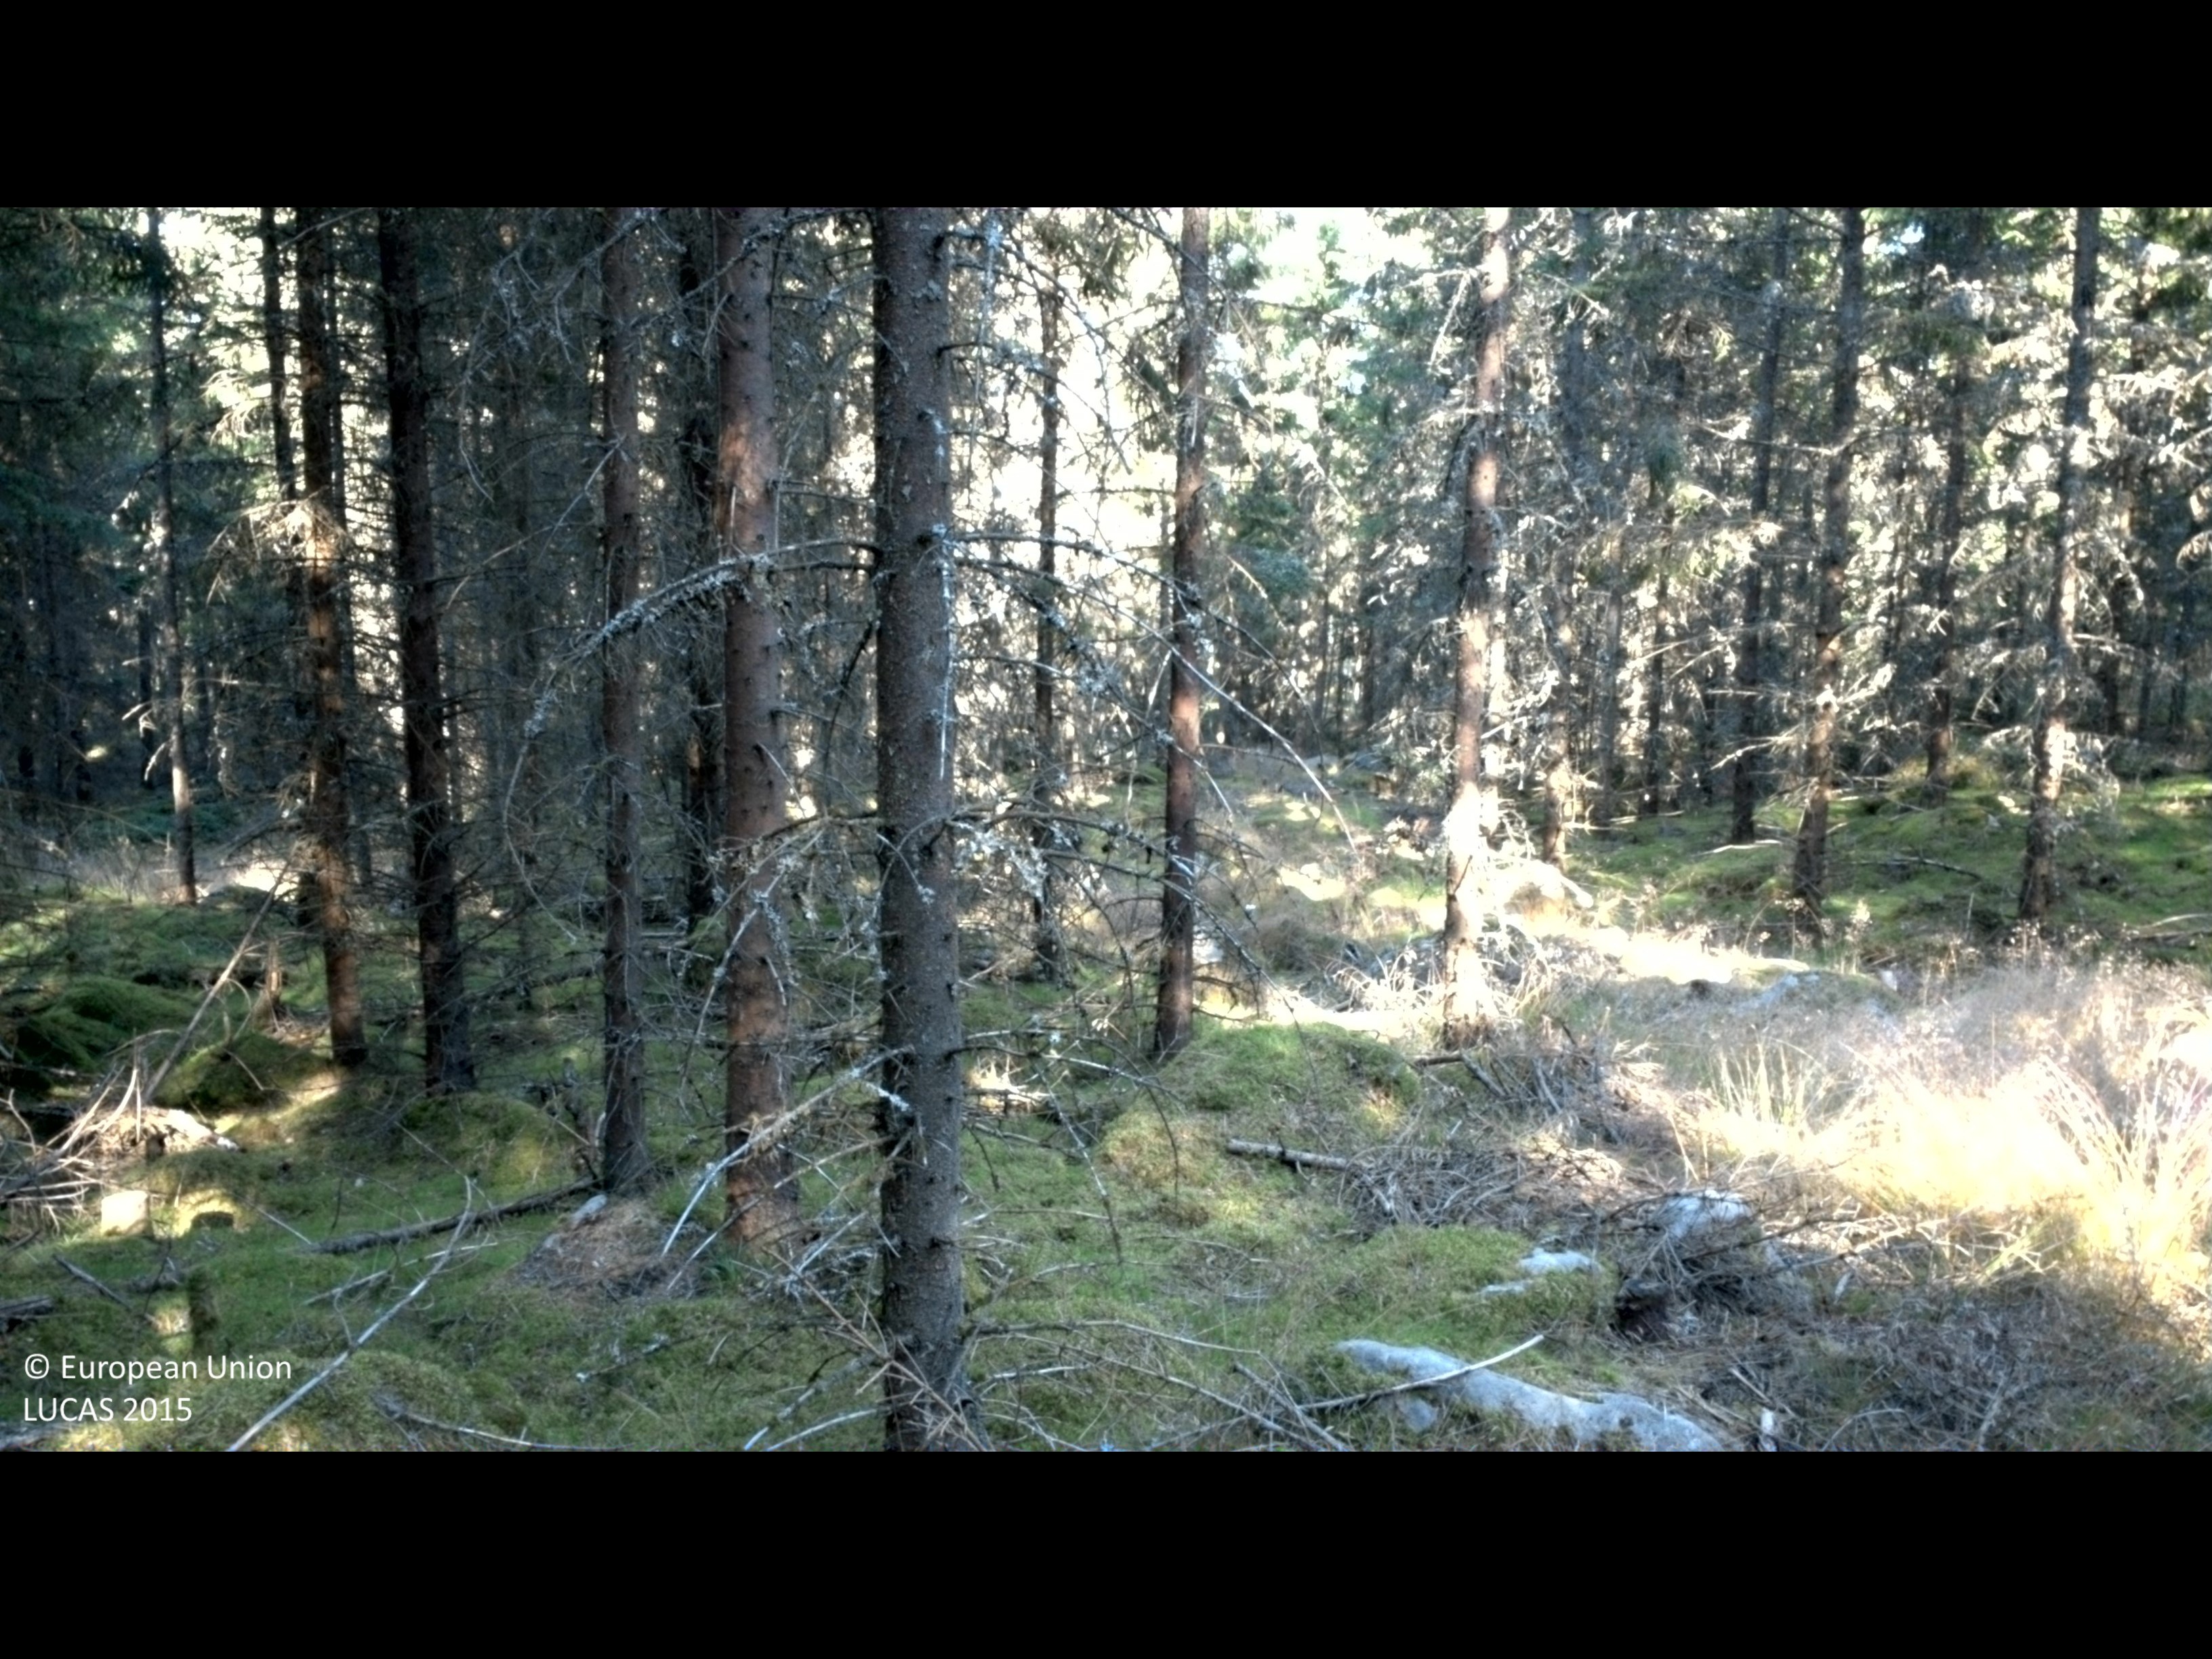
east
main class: Woodland
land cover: Spruce dominated coniferous woodland
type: boreal forest
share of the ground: > 75 %
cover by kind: coniferous forest trees 85 %, lichens and mosses 10 %, herbaceous plants 5 %
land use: Forestry
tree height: > 5 m
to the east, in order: Spruce dominated coniferous woodland; Pine dominated mixed woodland; Pine dominated coniferous woodland; Inland fresh water bodies; Broadleaved woodland
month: August
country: SE
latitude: 56.8200
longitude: 14.2401
